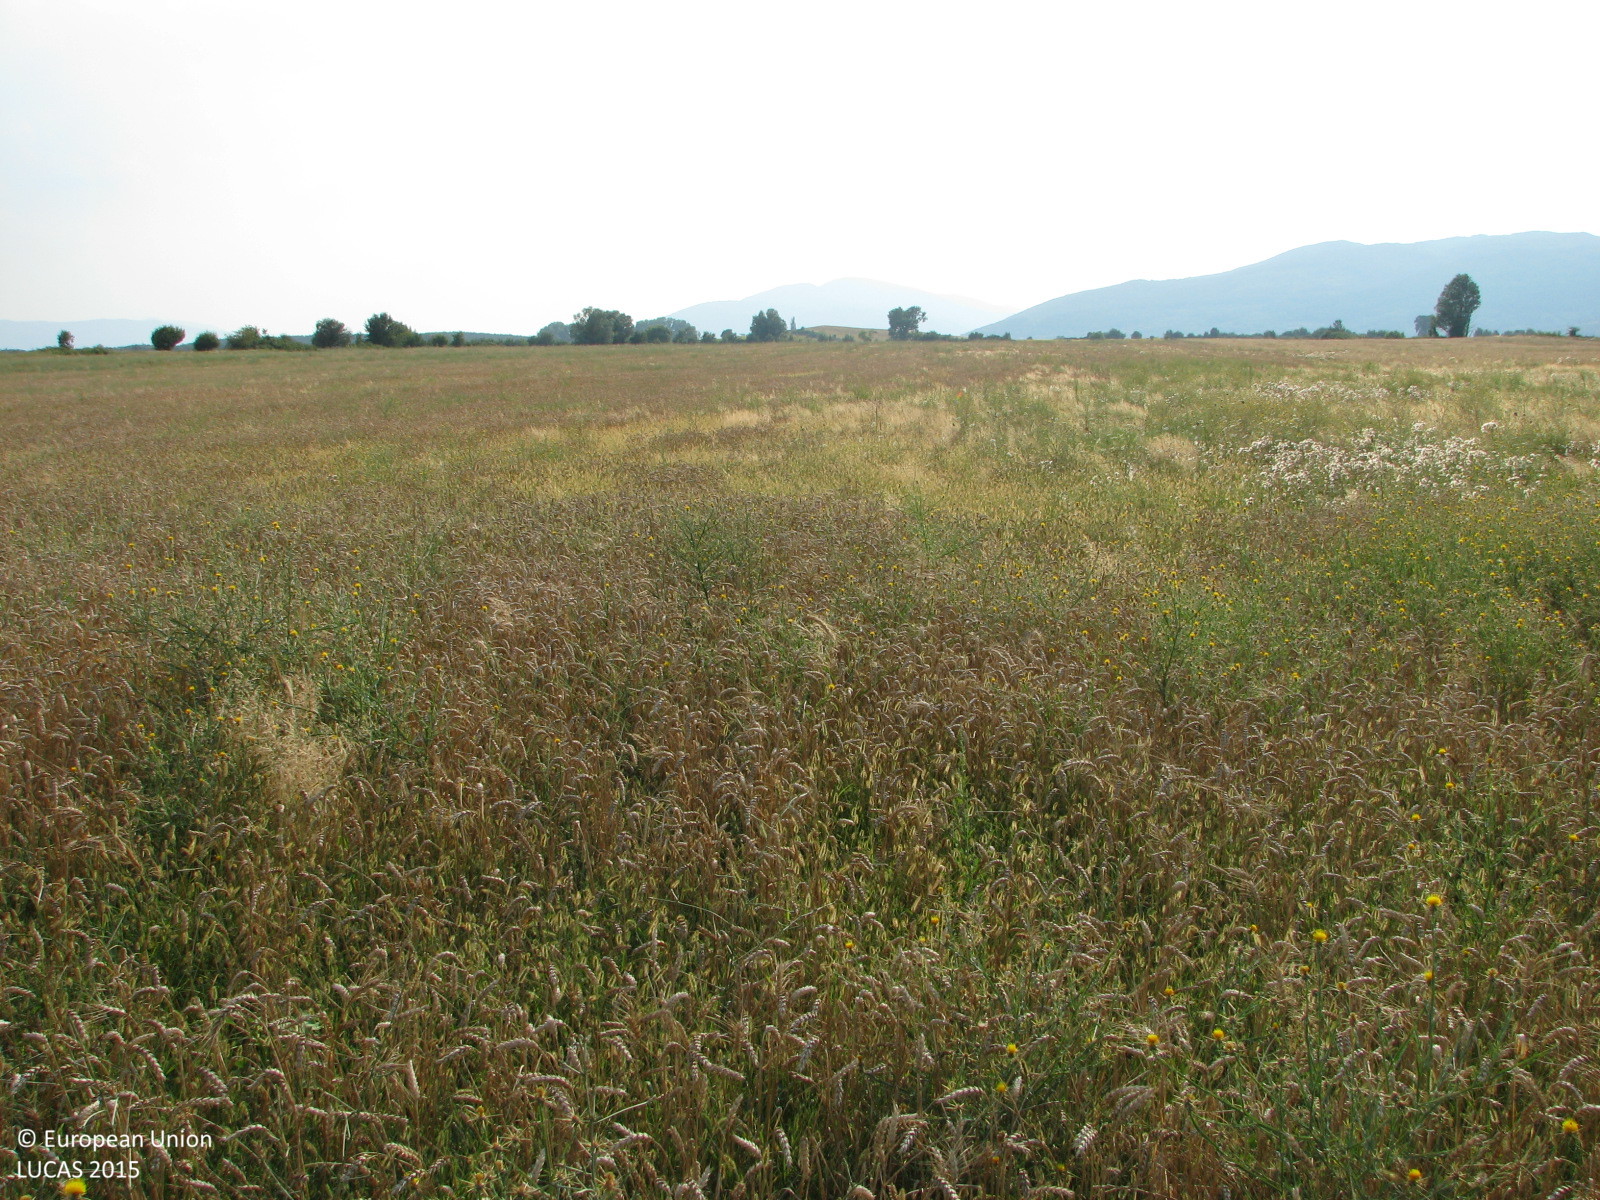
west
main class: Cropland
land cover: Common wheat
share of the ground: > 75 %
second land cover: Spontaneously vegetated surfaces
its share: 10 - 25 %
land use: Agriculture (excluding fallow land and kitchen gardens)
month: July
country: BG
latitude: 42.6809
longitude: 25.8594
